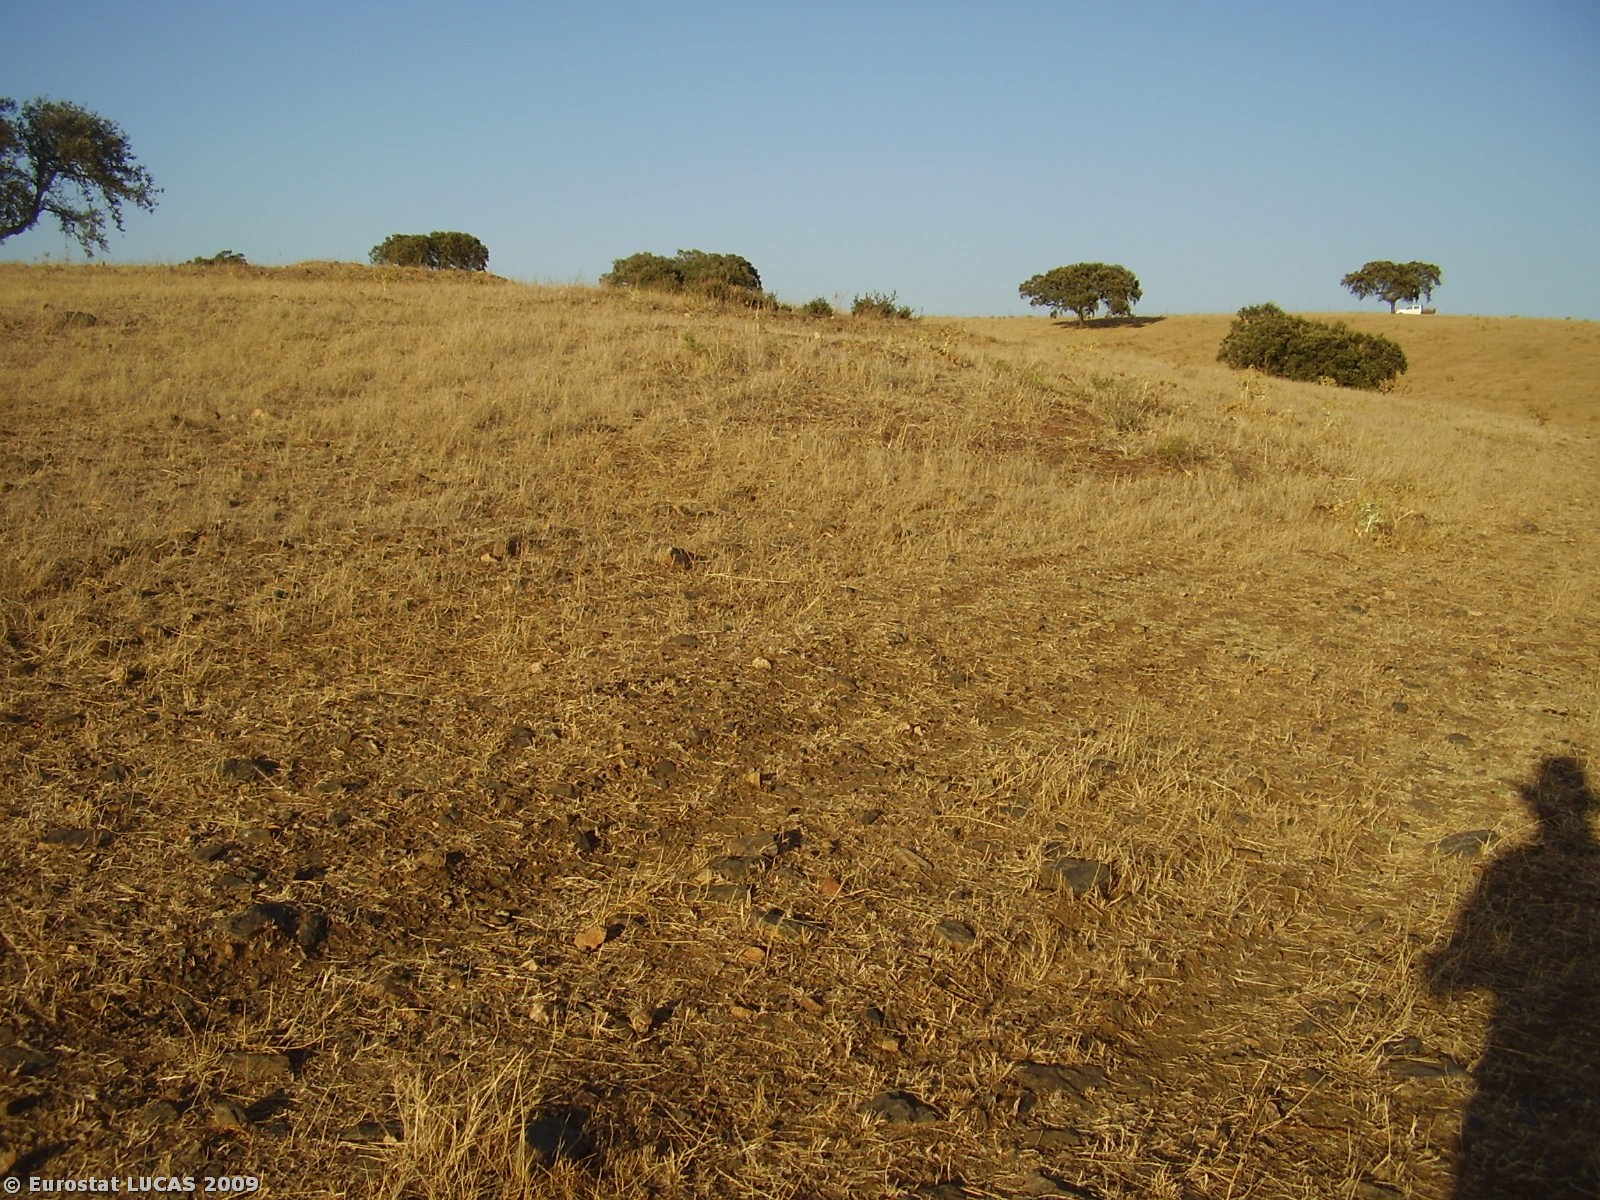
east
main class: Grassland
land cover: Grassland without tree/shrub cover
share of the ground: > 75 %
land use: Fallow land
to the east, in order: Grassland without tree/shrub cover; Grassland with sparse tree/shrub cover; Grassland without tree/shrub cover; Tracks
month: July
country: PT
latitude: 38.0480
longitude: -7.7221
